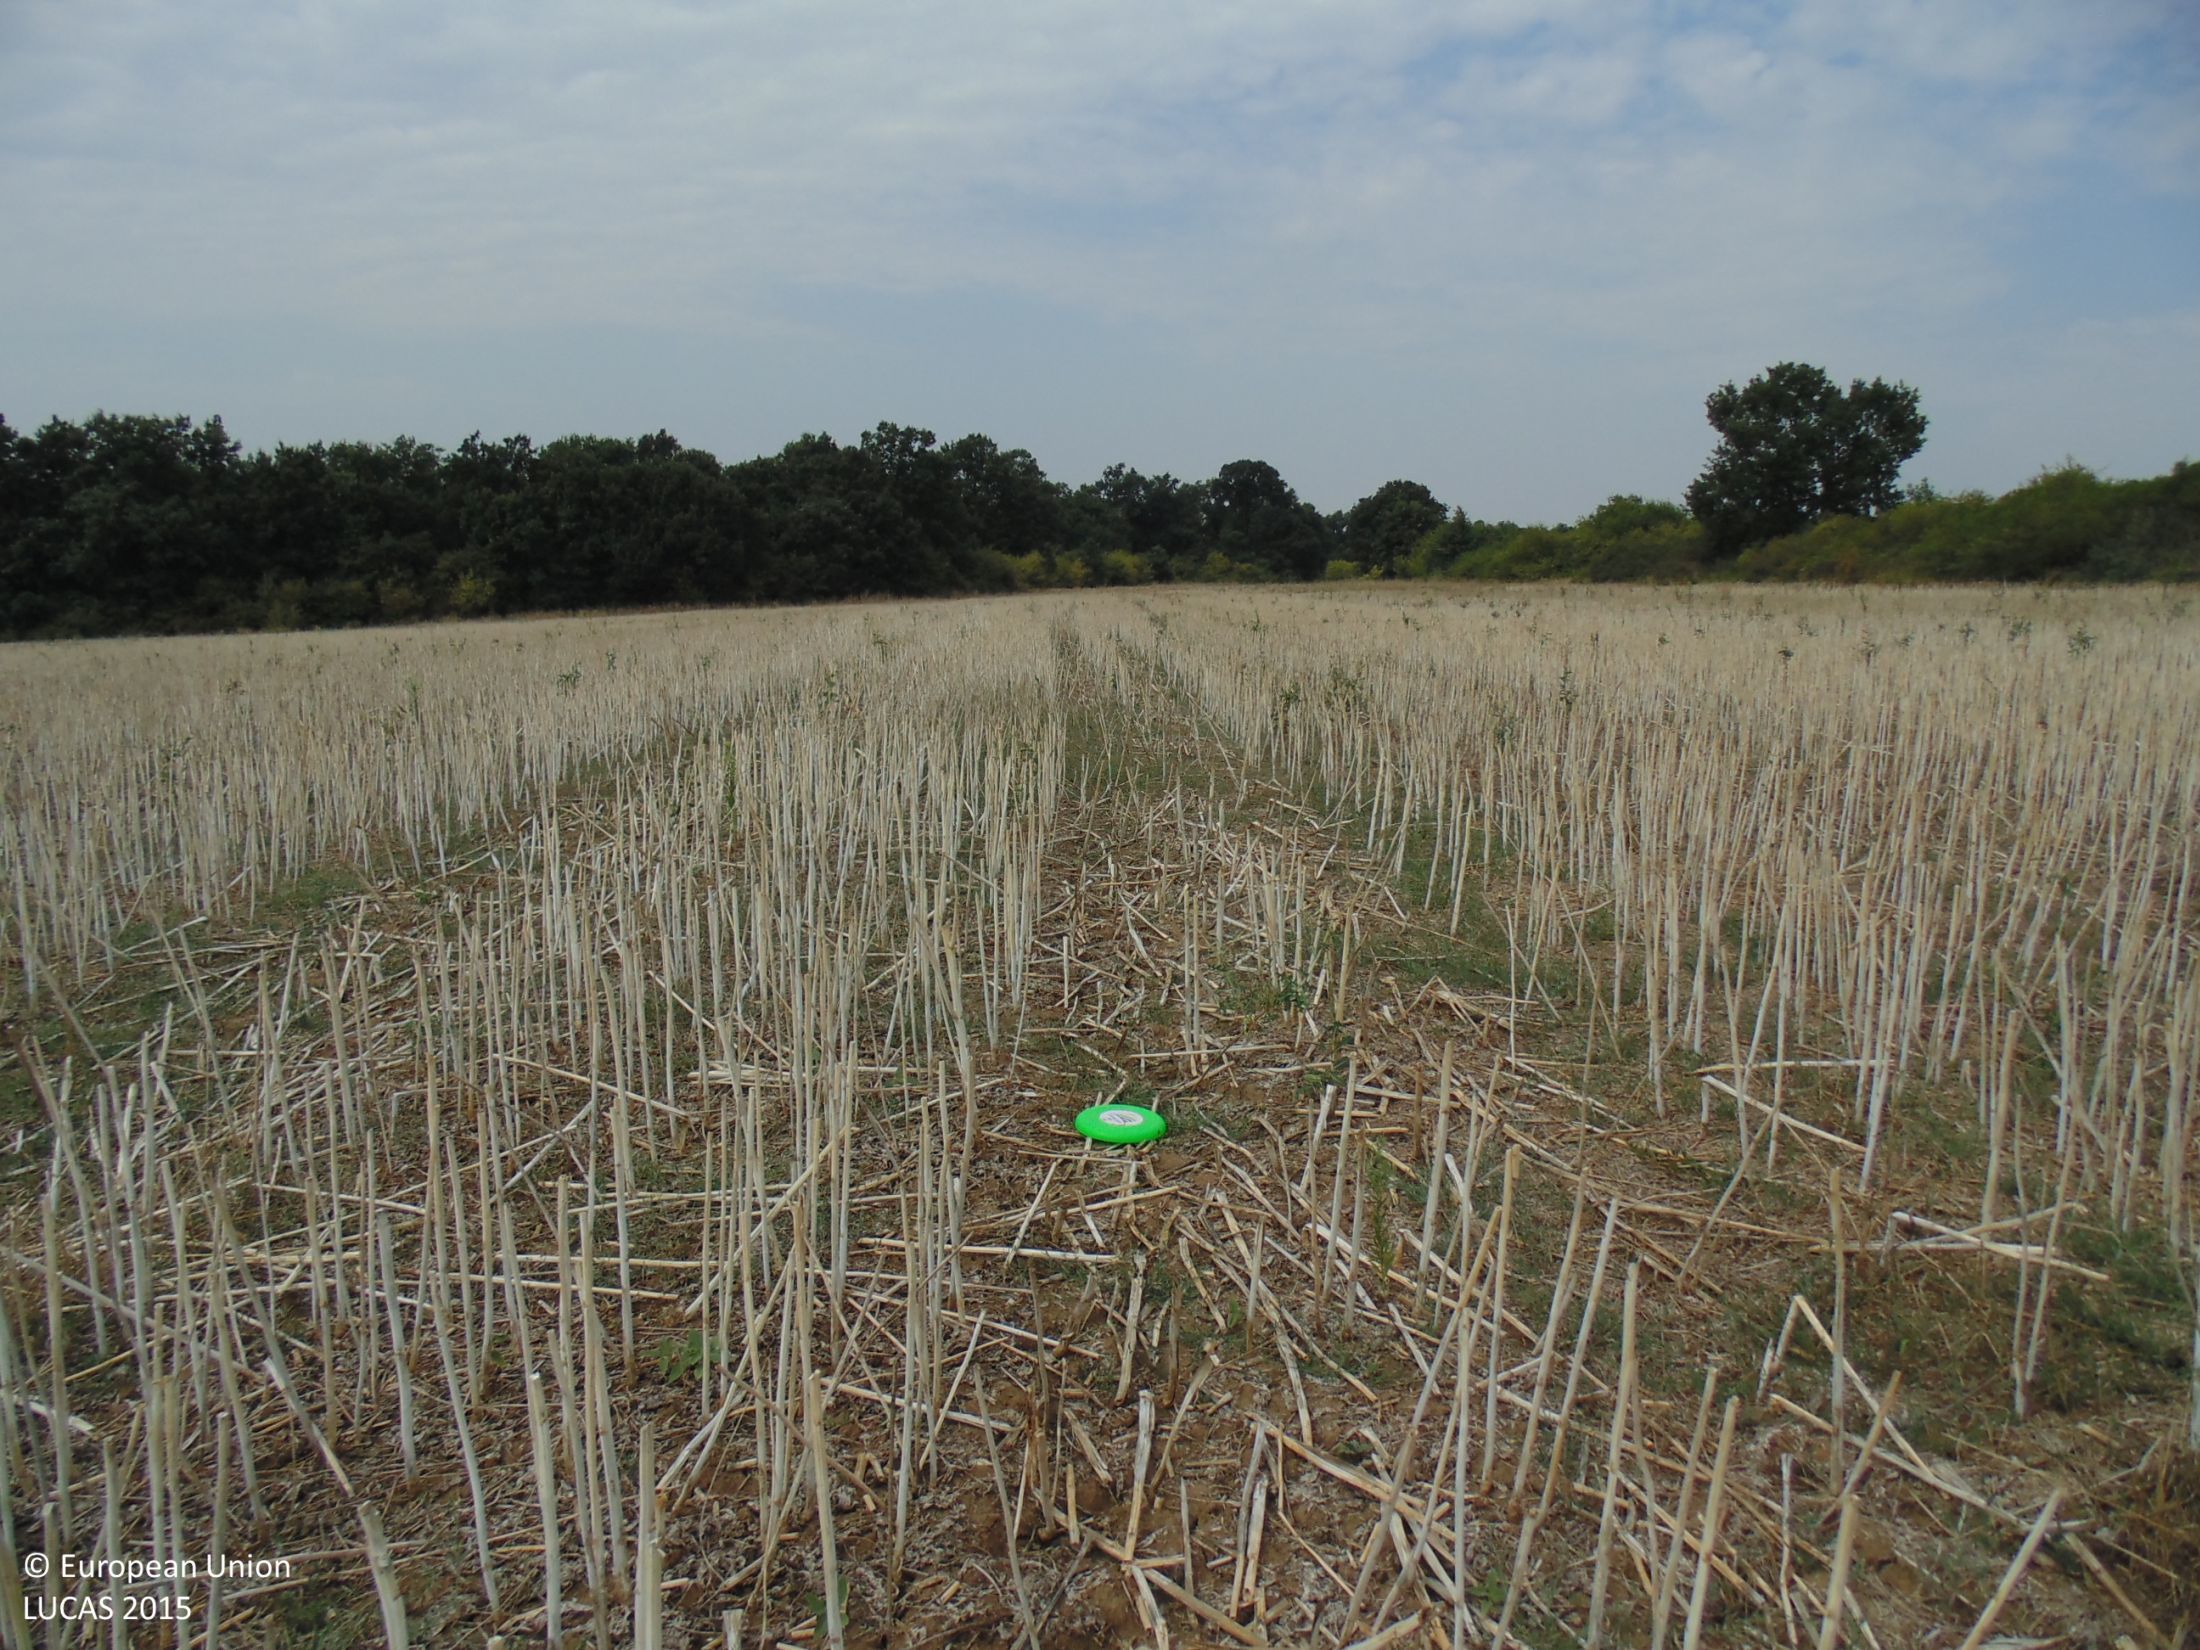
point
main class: Cropland
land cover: Rape and turnip rape
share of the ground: 50 - 75 %
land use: Agriculture (excluding fallow land and kitchen gardens)
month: August
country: BG
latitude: 43.7819
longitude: 27.6462
